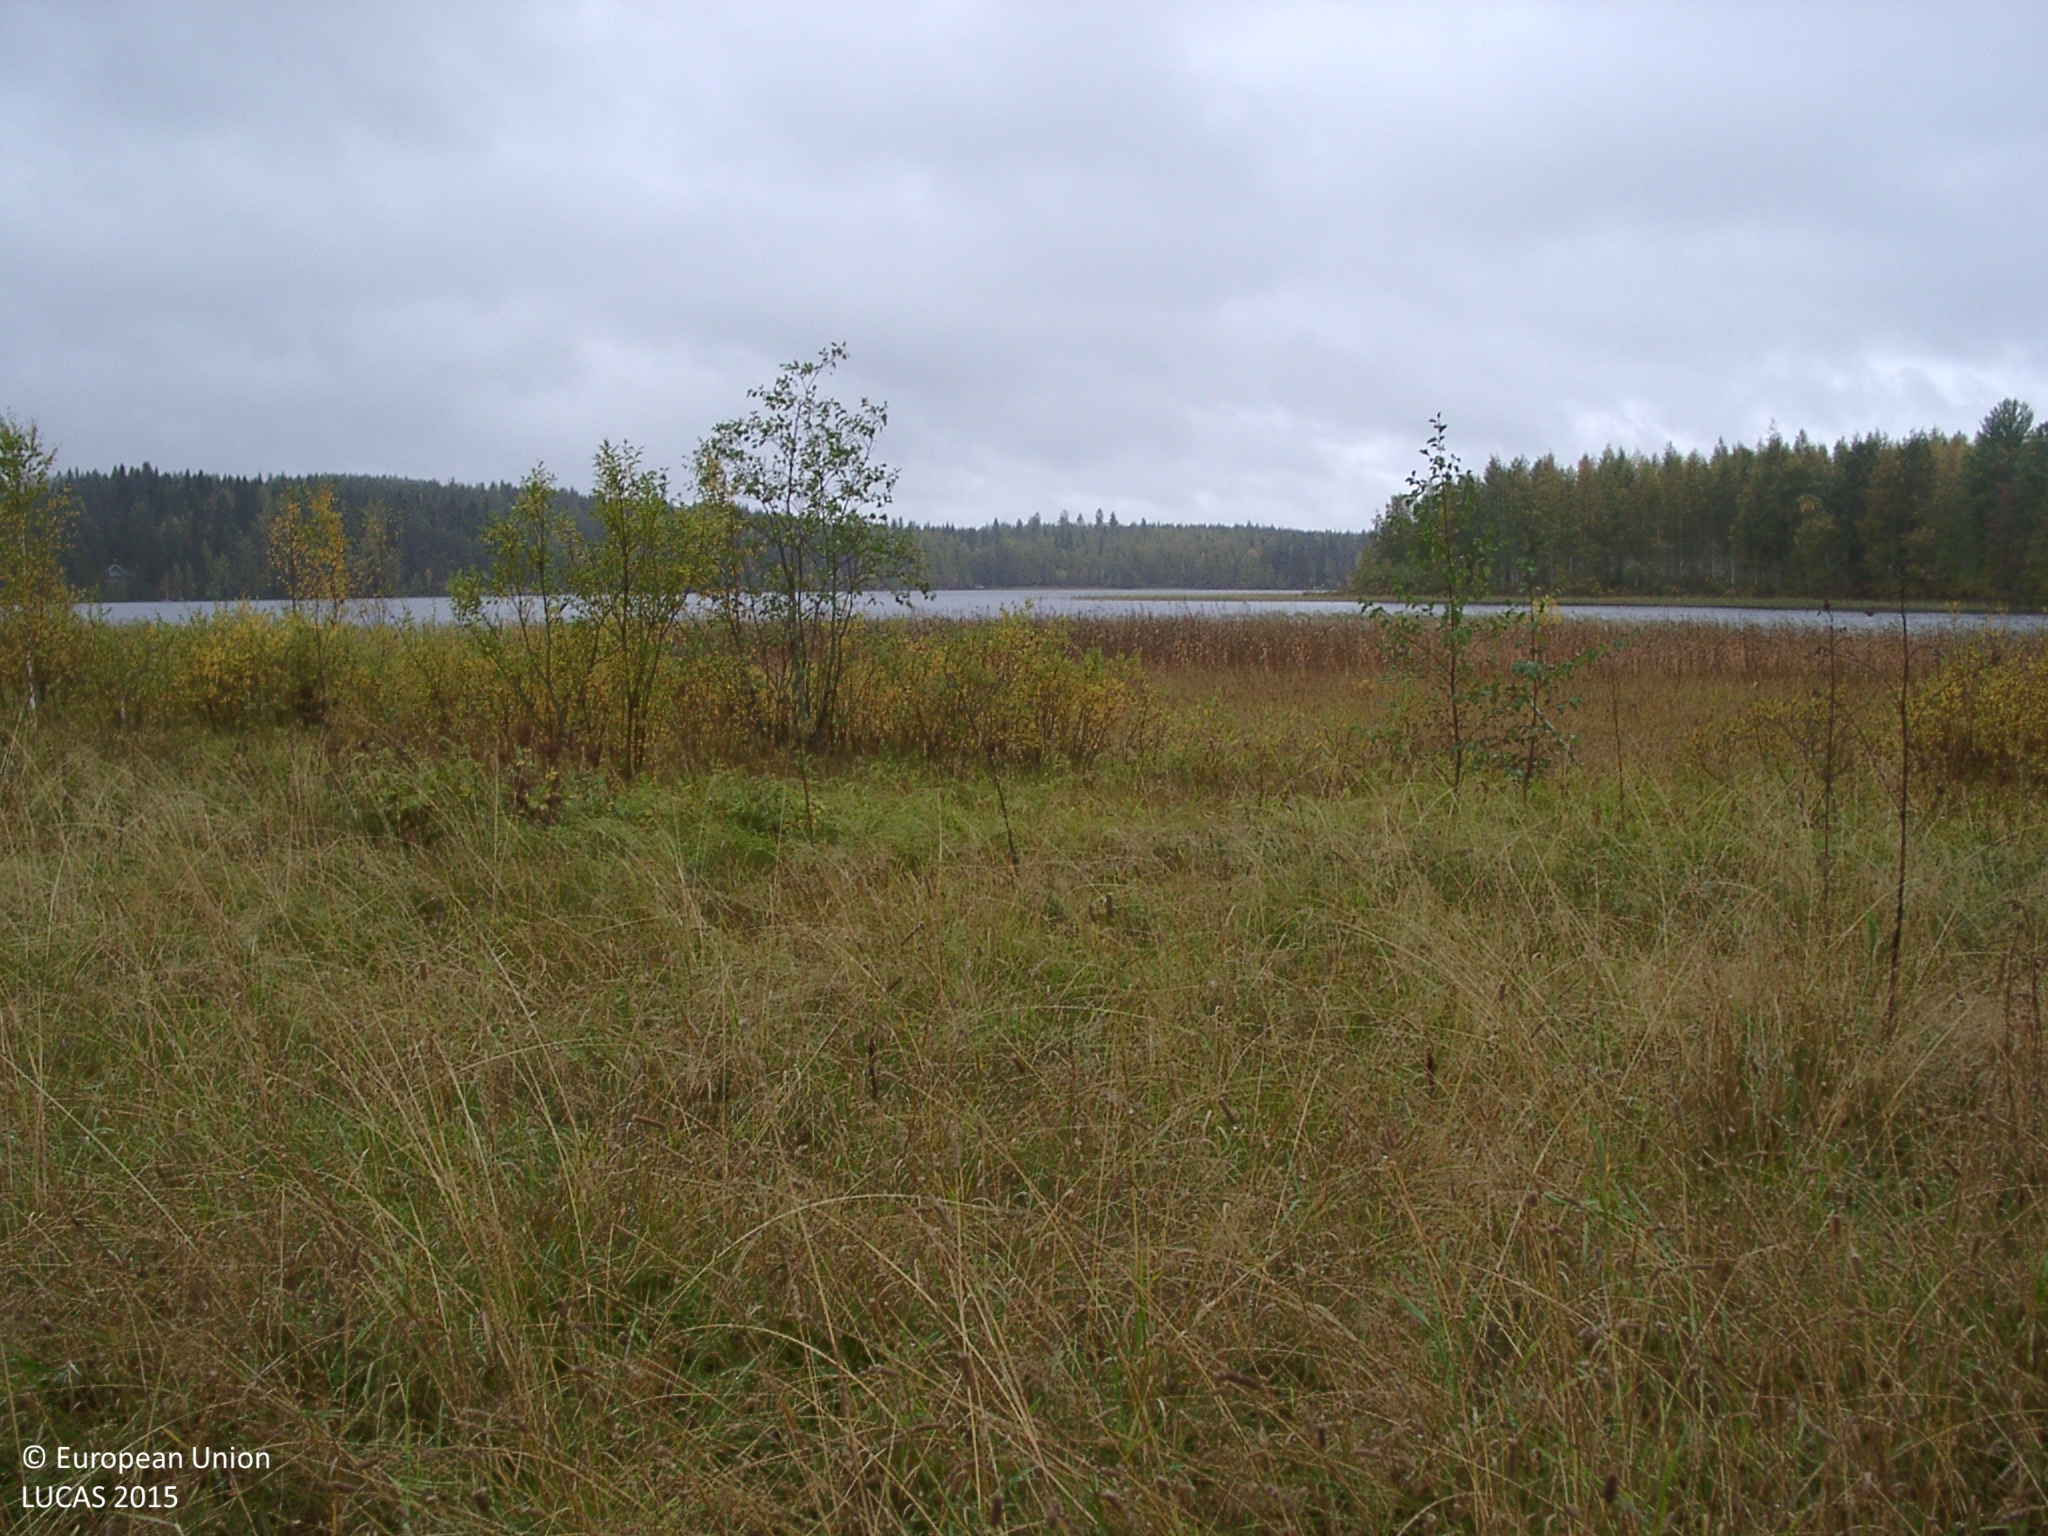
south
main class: Grassland
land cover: Grassland without tree/shrub cover
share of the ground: > 75 %
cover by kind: herbaceous plants 100 %
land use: Agriculture (excluding fallow land and kitchen gardens)
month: September
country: FI
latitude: 62.7595
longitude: 25.5214
